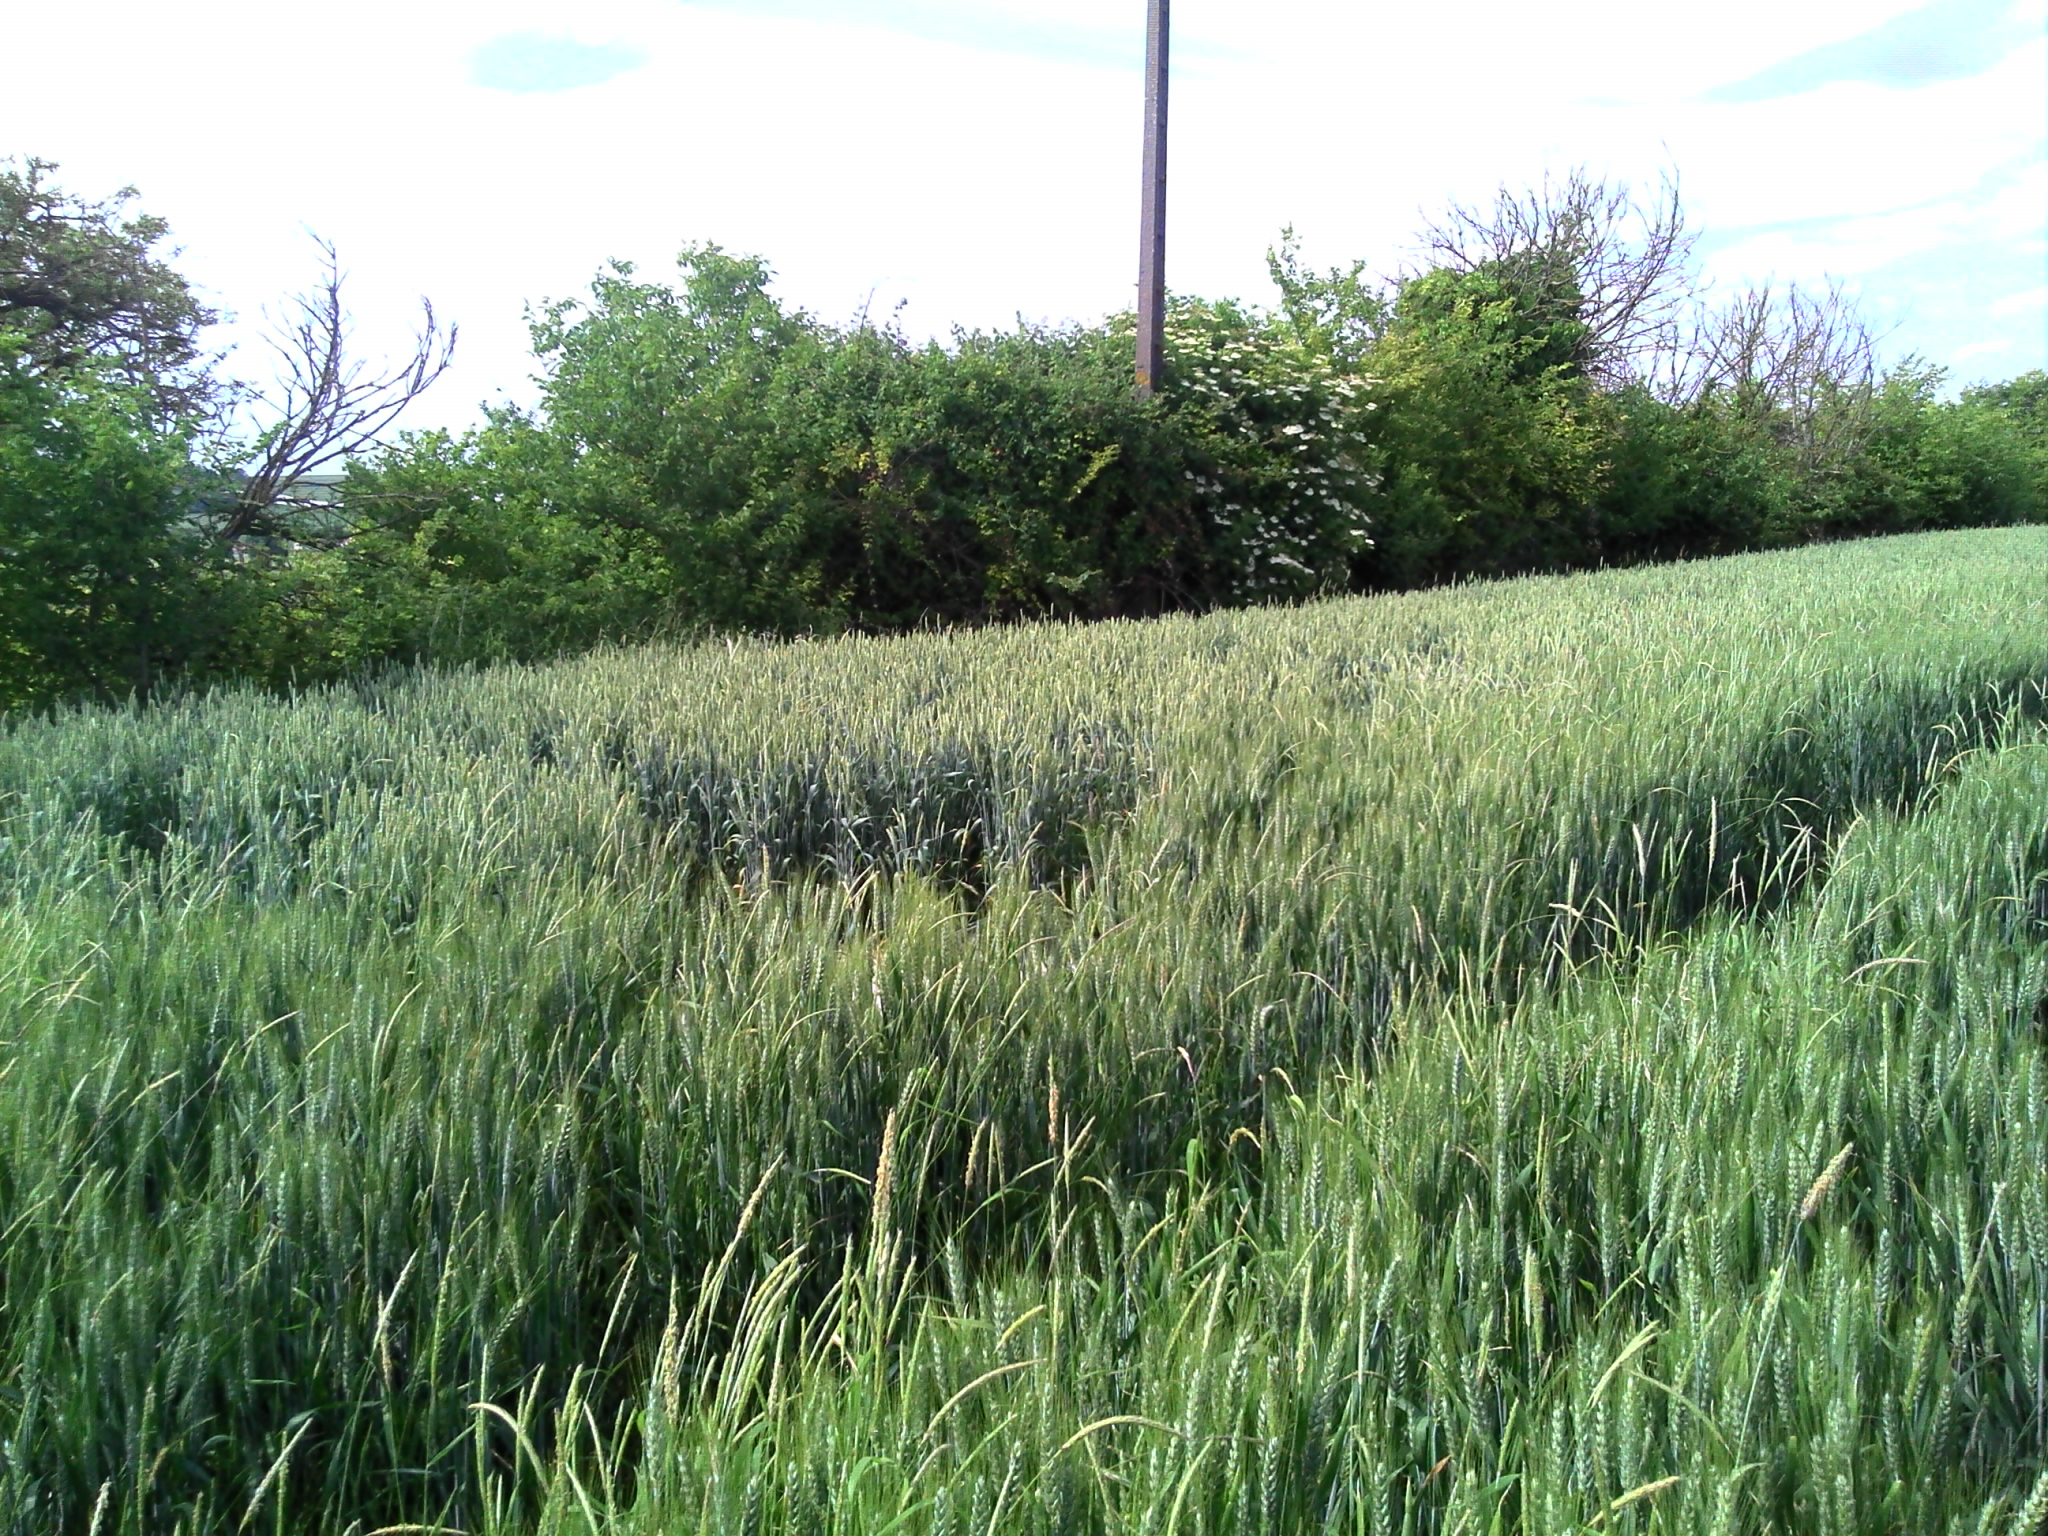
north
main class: Cropland
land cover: Common wheat
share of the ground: > 75 %
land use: Agriculture (excluding fallow land and kitchen gardens)
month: May
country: FR
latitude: 46.9140
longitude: 0.3817
